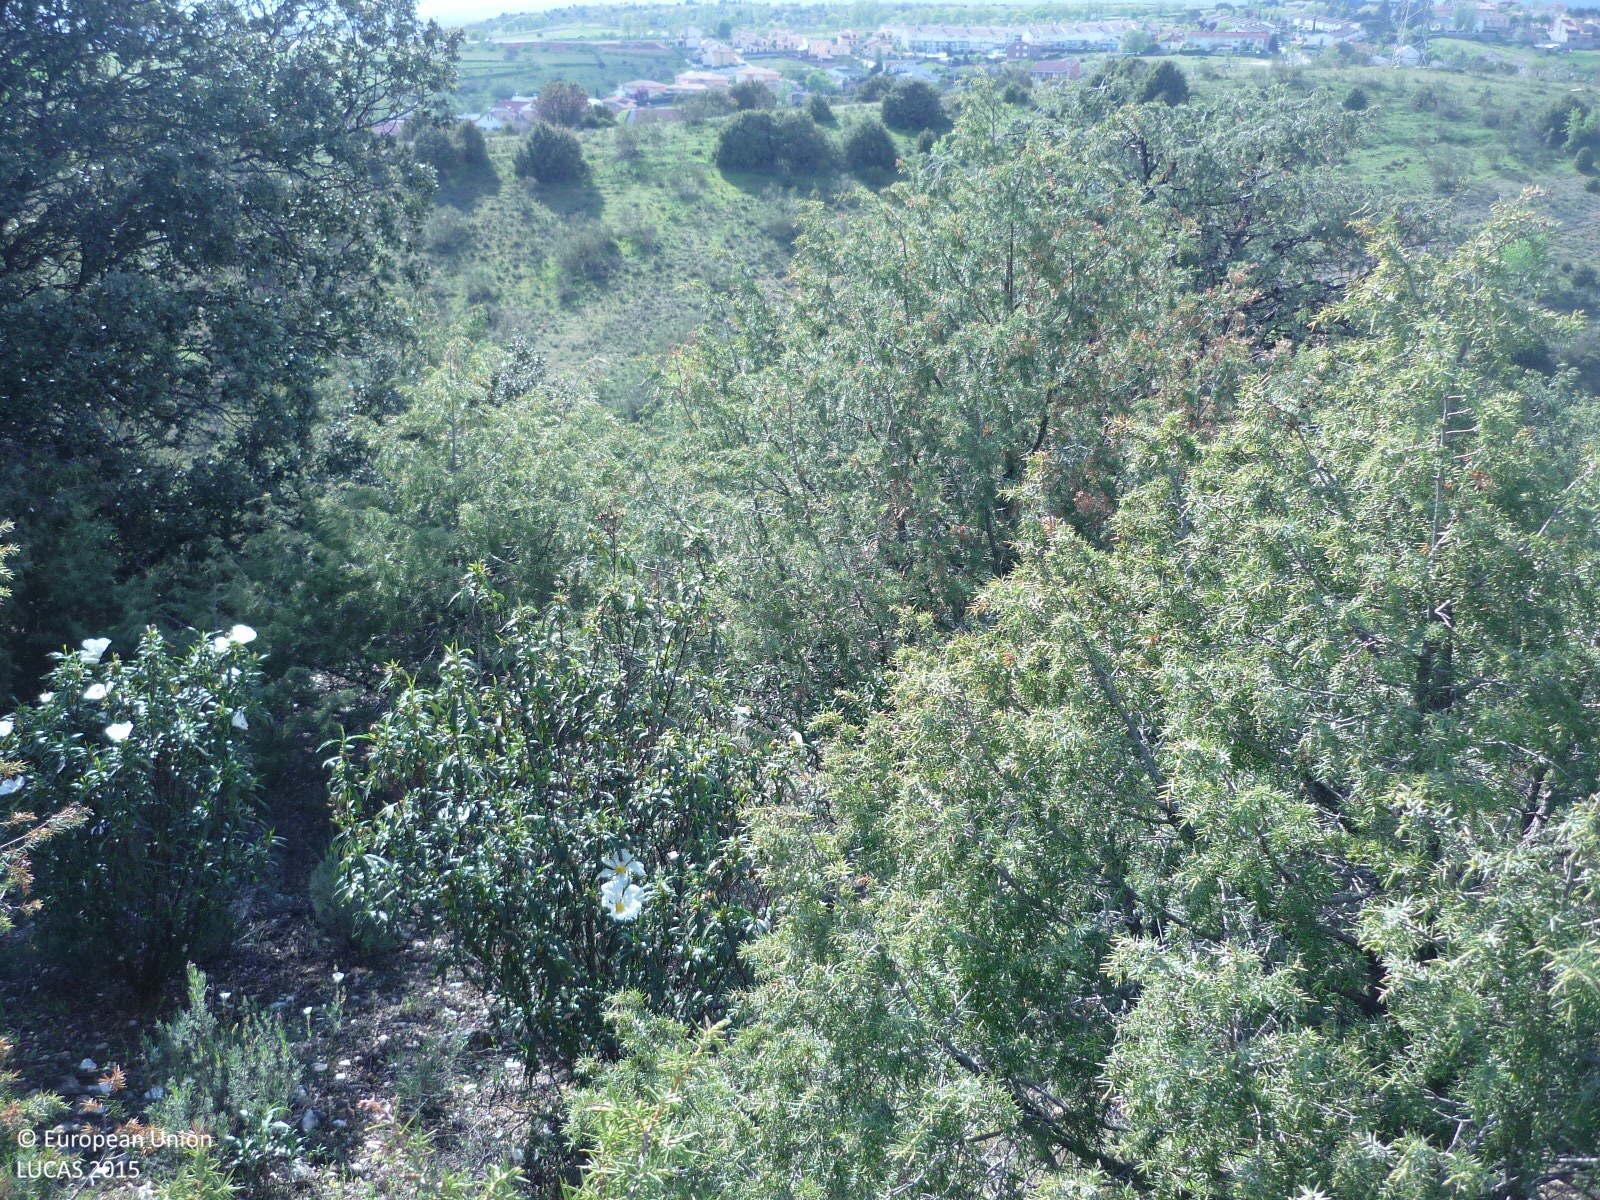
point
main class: Woodland
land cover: Other coniferous woodland
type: coniferous forest of the mediterranean region
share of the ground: 25 - 50 %
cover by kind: coniferous forest trees 40 %, shrubs 20 %, herbaceous plants 20 %, unconsolidated bare surface 20 %
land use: Semi-natural and natural areas not in use
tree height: < 5 m
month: April
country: ES
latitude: 40.8149
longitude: -3.6158
